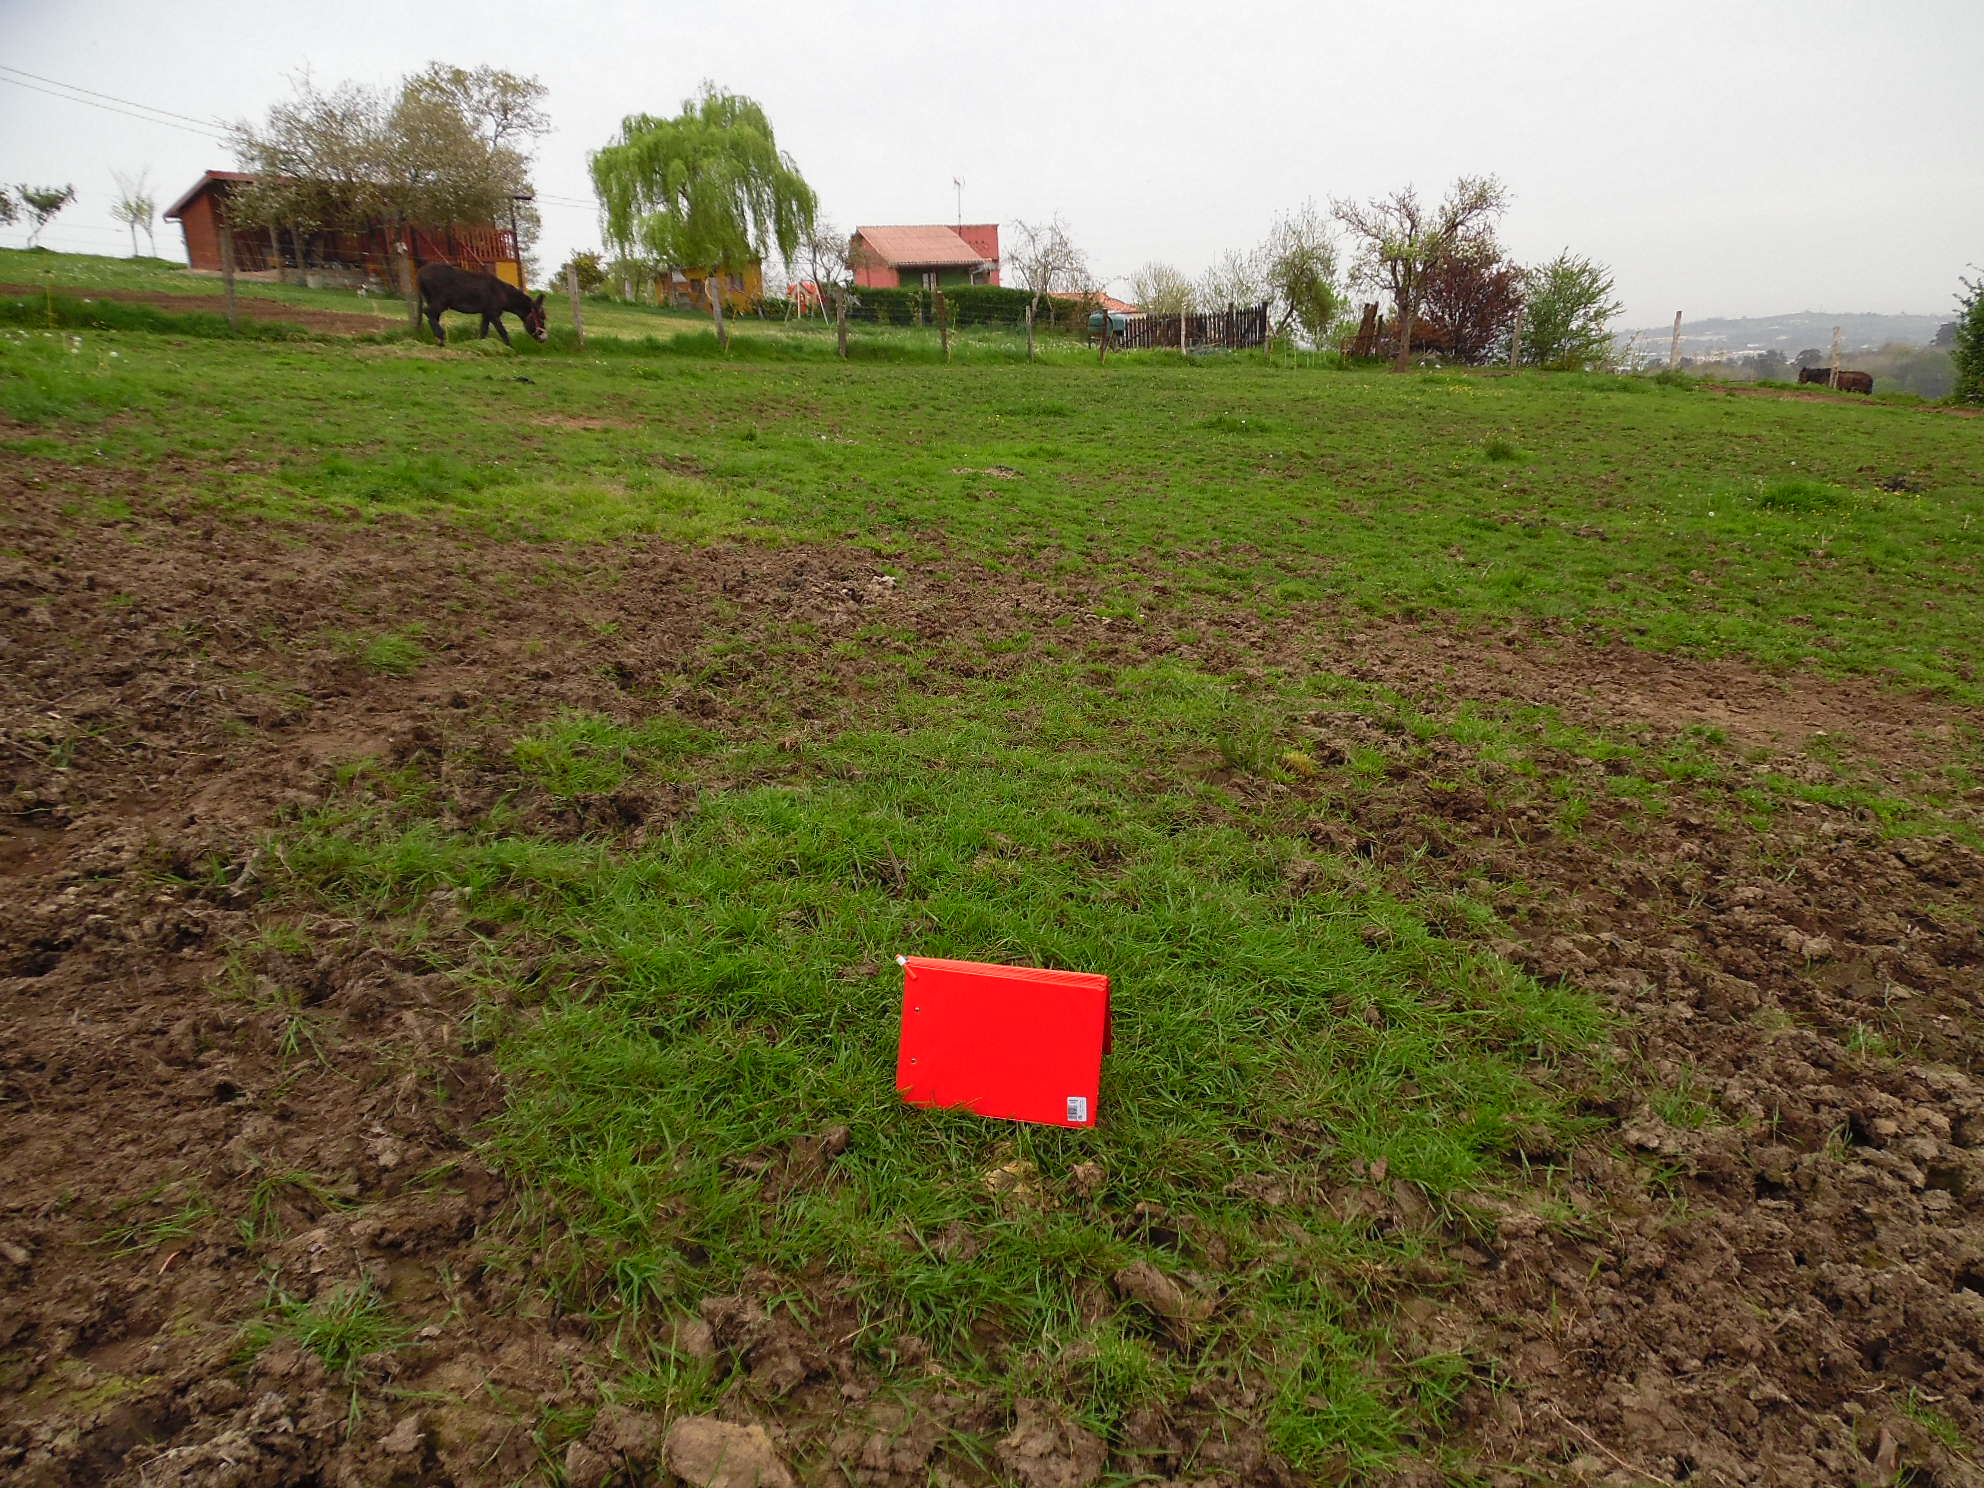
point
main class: Grassland
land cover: Grassland without tree/shrub cover
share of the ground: 25 - 50 %
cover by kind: unconsolidated bare surface 55 %, herbaceous plants 45 %
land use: Agriculture (excluding fallow land and kitchen gardens)
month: April
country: ES
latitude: 43.4014
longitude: -5.8307
